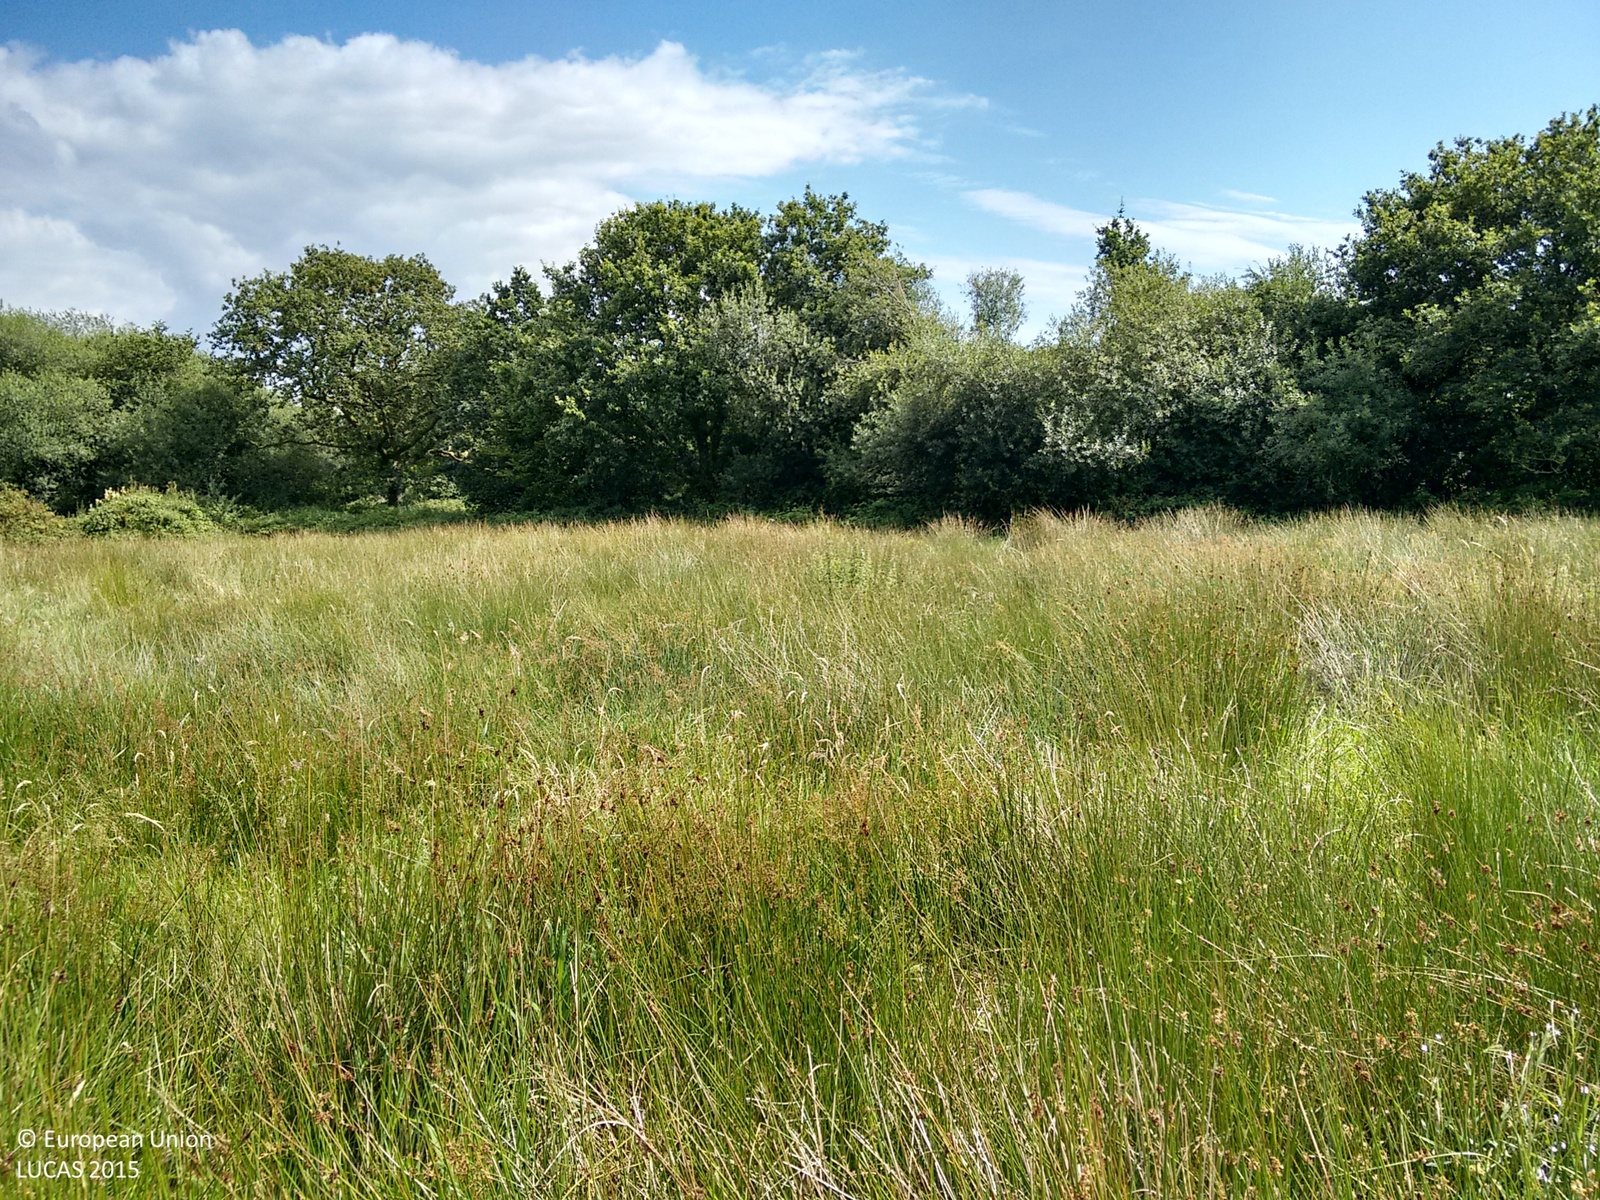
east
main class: Grassland
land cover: Grassland without tree/shrub cover
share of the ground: > 75 %
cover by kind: herbaceous plants 100 %
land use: Agriculture (excluding fallow land and kitchen gardens)
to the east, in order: Grassland without tree/shrub cover; Shrubland without tree cover; Ditches and canals; Fences; Broadleaved woodland; Tracks; Grassland without tree/shrub cover; Lines of trees; Rivers and streams; Lines of trees; Grassland without tree/shrub cover
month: August
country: GB
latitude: 51.8158
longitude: -4.4510
